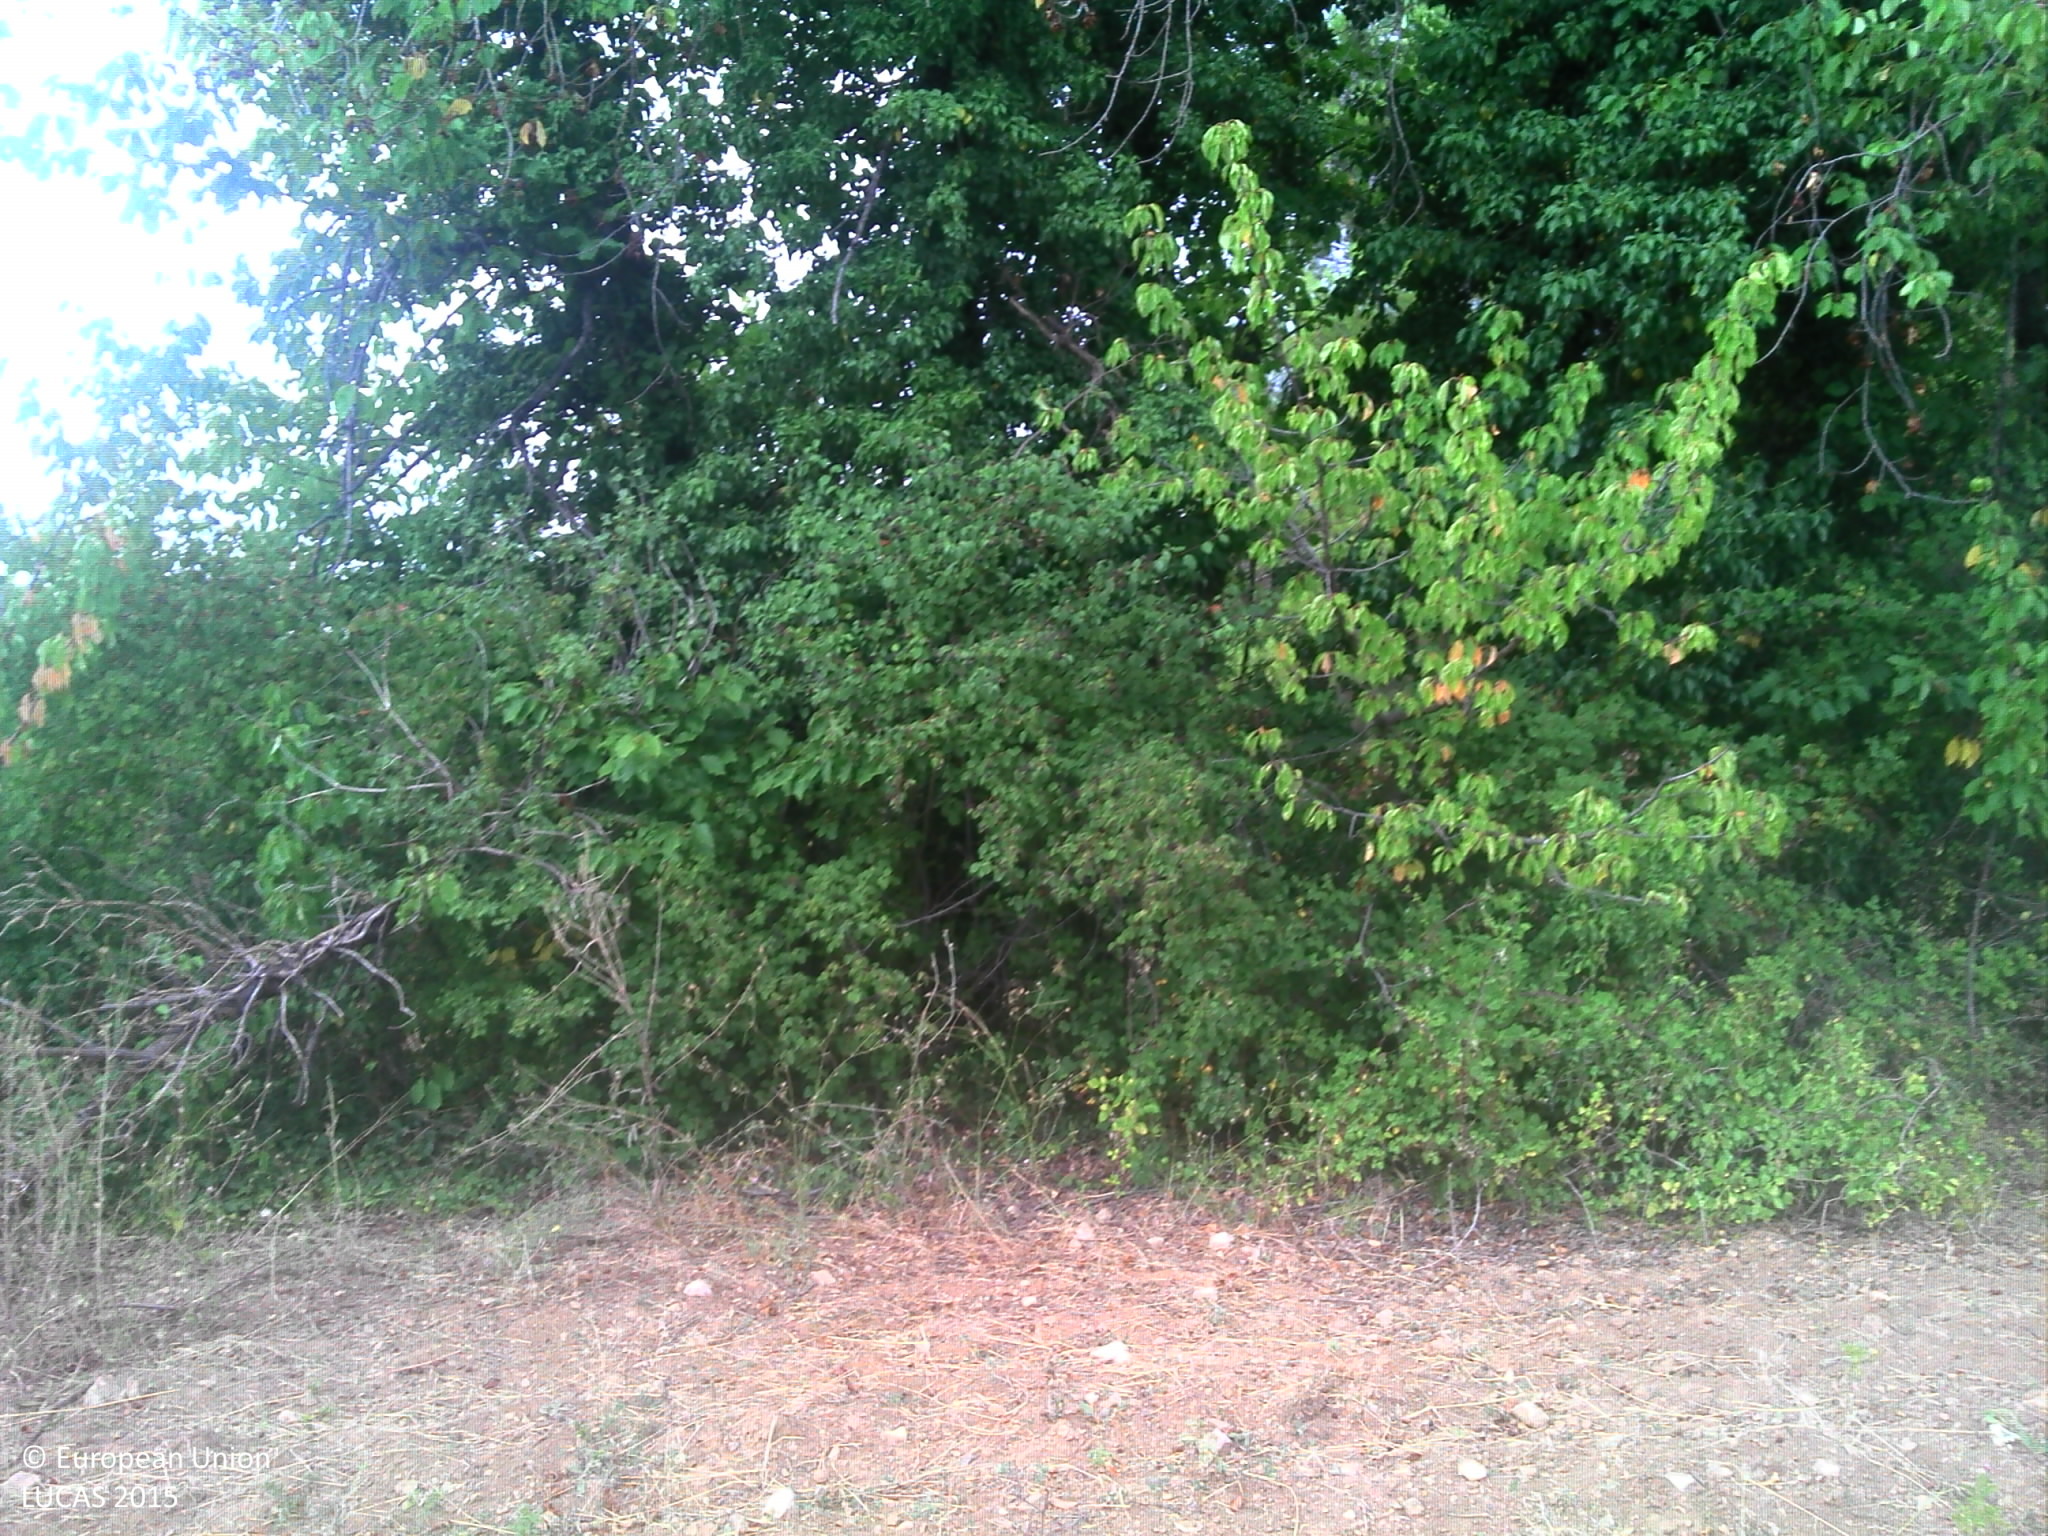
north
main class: Grassland
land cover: Spontaneously vegetated surfaces
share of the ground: 25 - 50 %
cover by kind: unconsolidated bare surface 55 %, herbaceous plants 45 %
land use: Fallow land
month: August
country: FR
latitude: 43.4209
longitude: 5.4770
